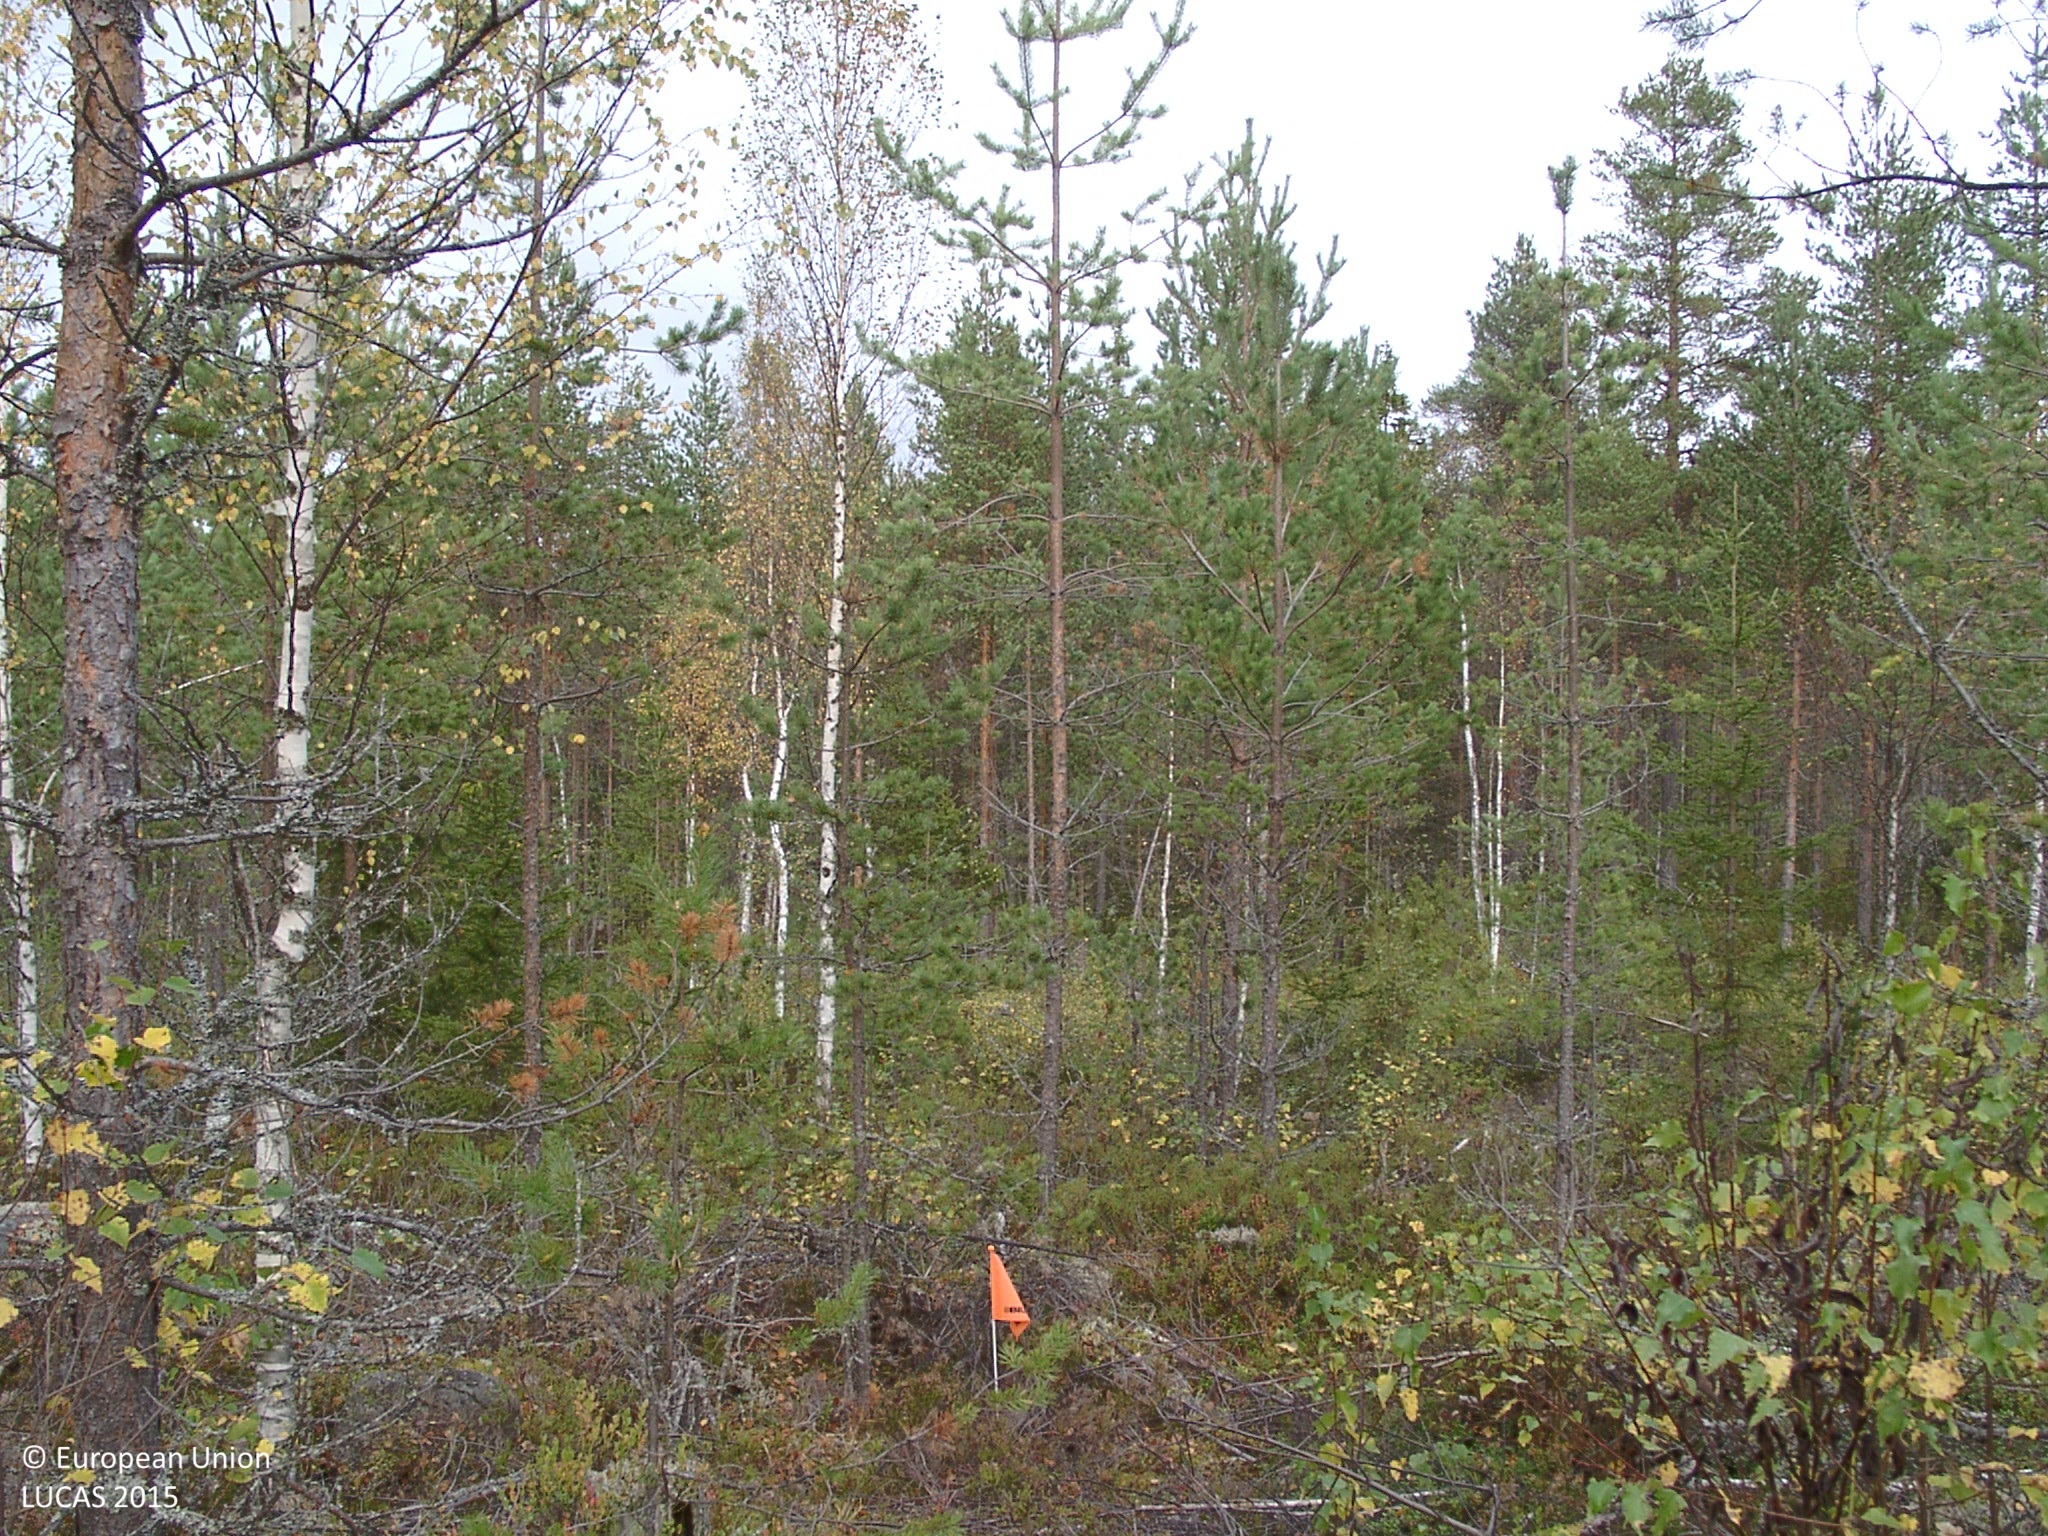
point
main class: Woodland
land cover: Pine dominated mixed woodland
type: boreal forest
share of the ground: 10 - 25 %
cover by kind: shrubs 40 %, lichens and mosses 30 %, coniferous forest trees 10 %, broadleaved forest trees 10 %
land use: Forestry
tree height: > 5 m
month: September
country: FI
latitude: 62.5804
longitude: 25.4681
